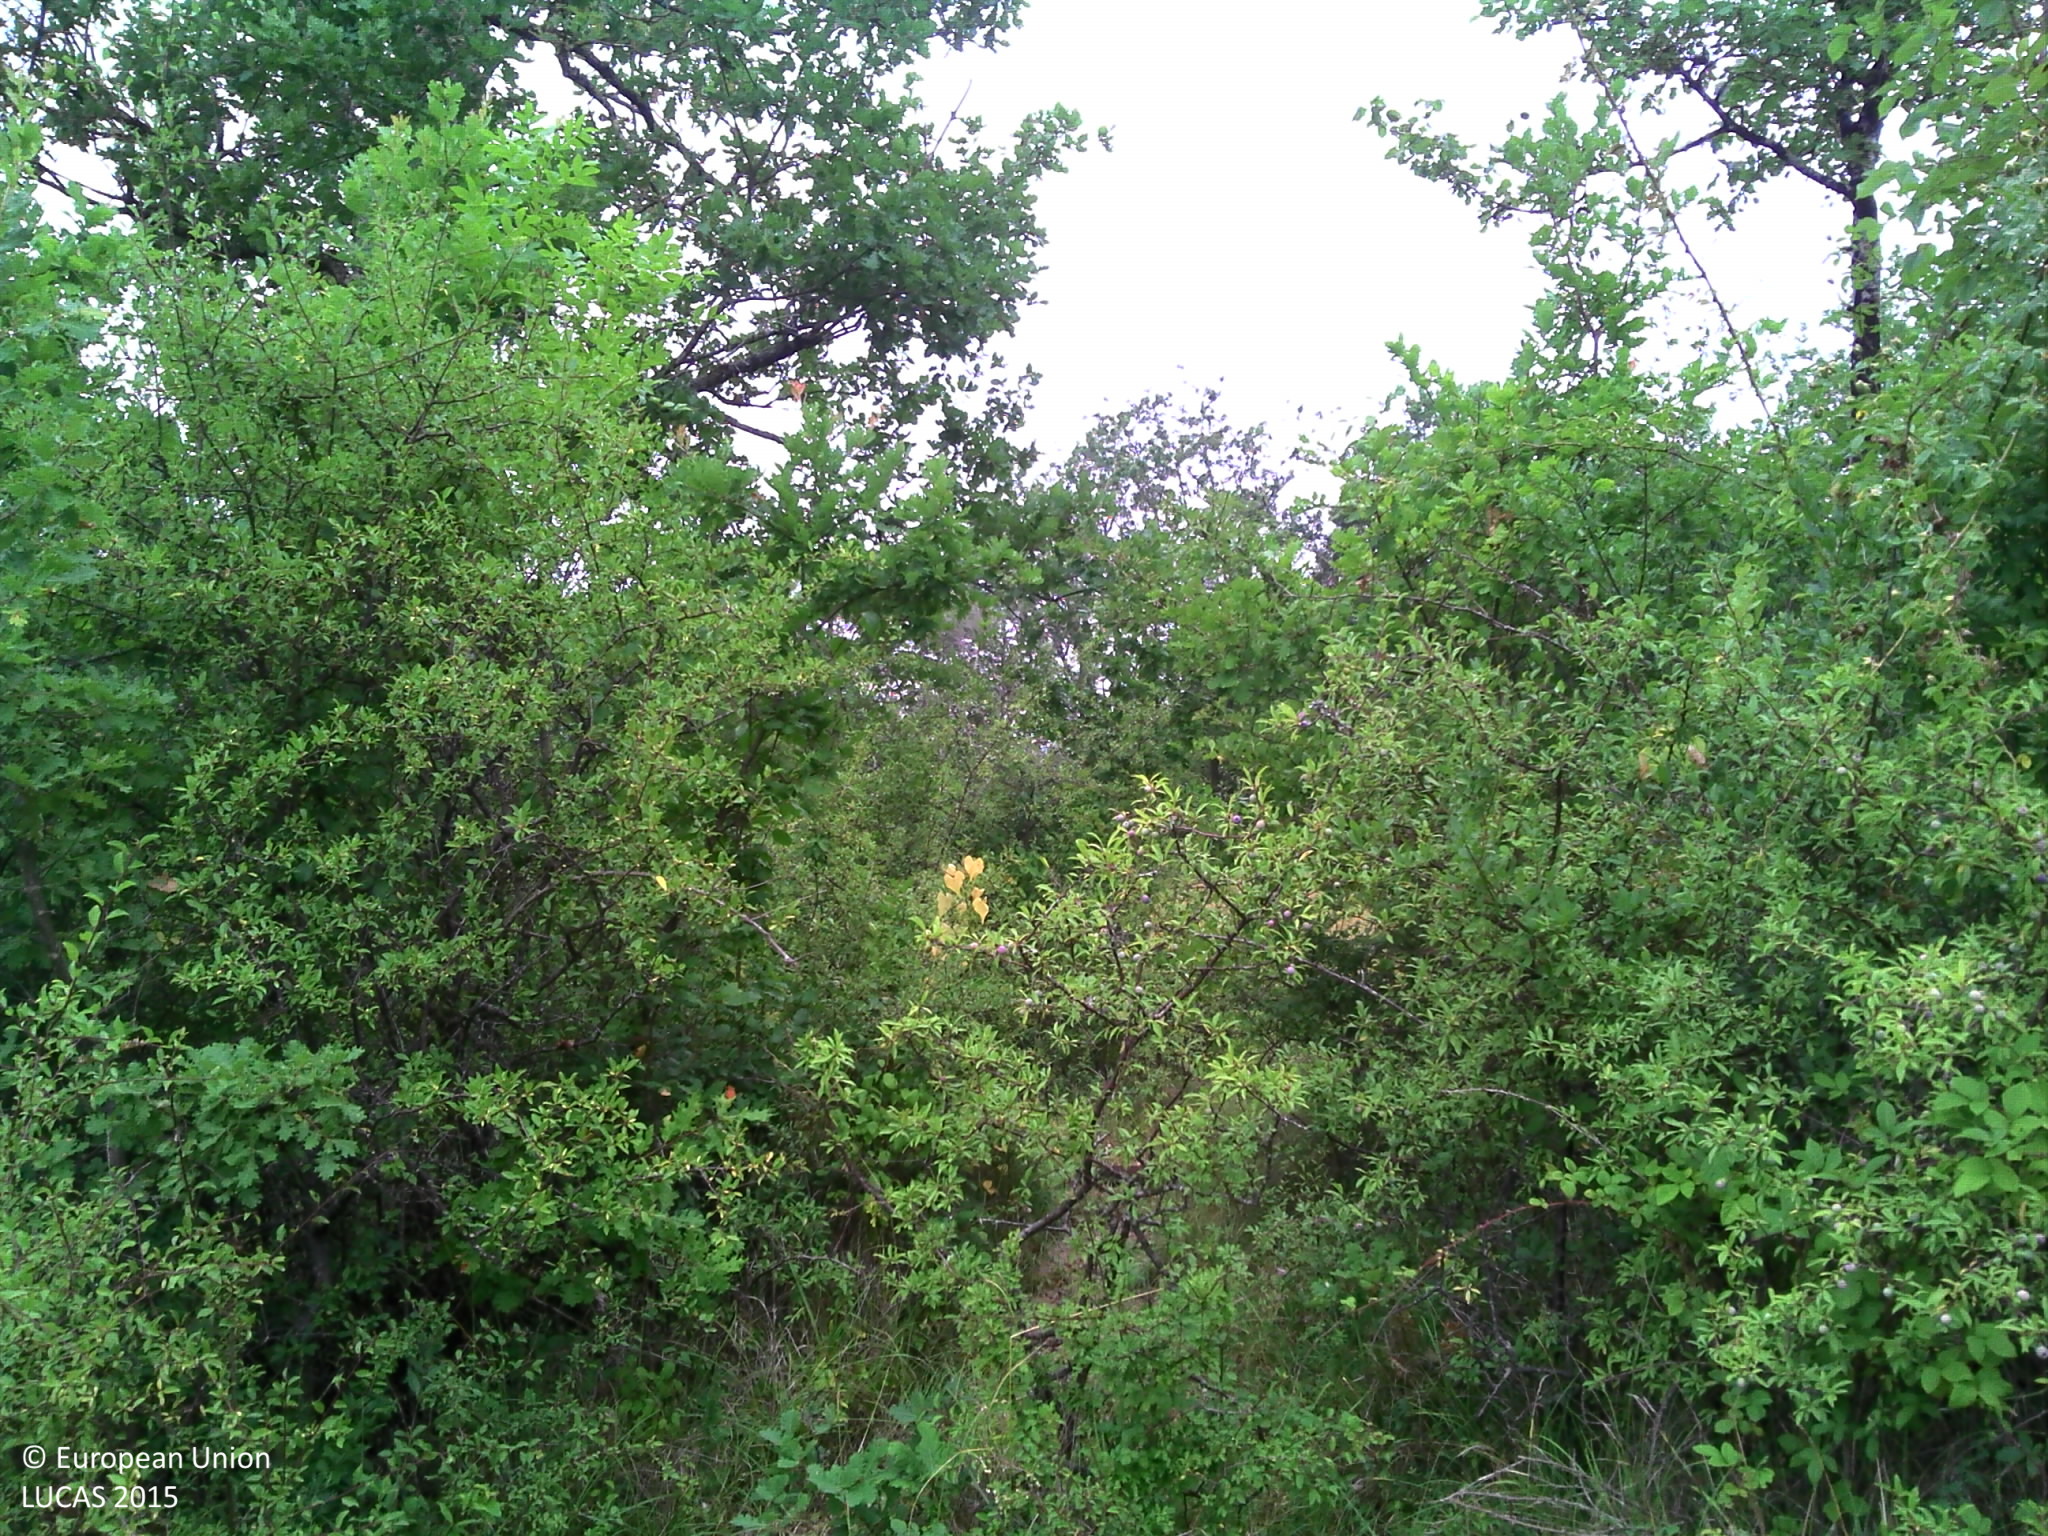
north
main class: Grassland
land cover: Grassland without tree/shrub cover
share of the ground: > 75 %
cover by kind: herbaceous plants 100 %
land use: Agriculture (excluding fallow land and kitchen gardens)
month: July
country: FR
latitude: 44.2776
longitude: 0.9122
